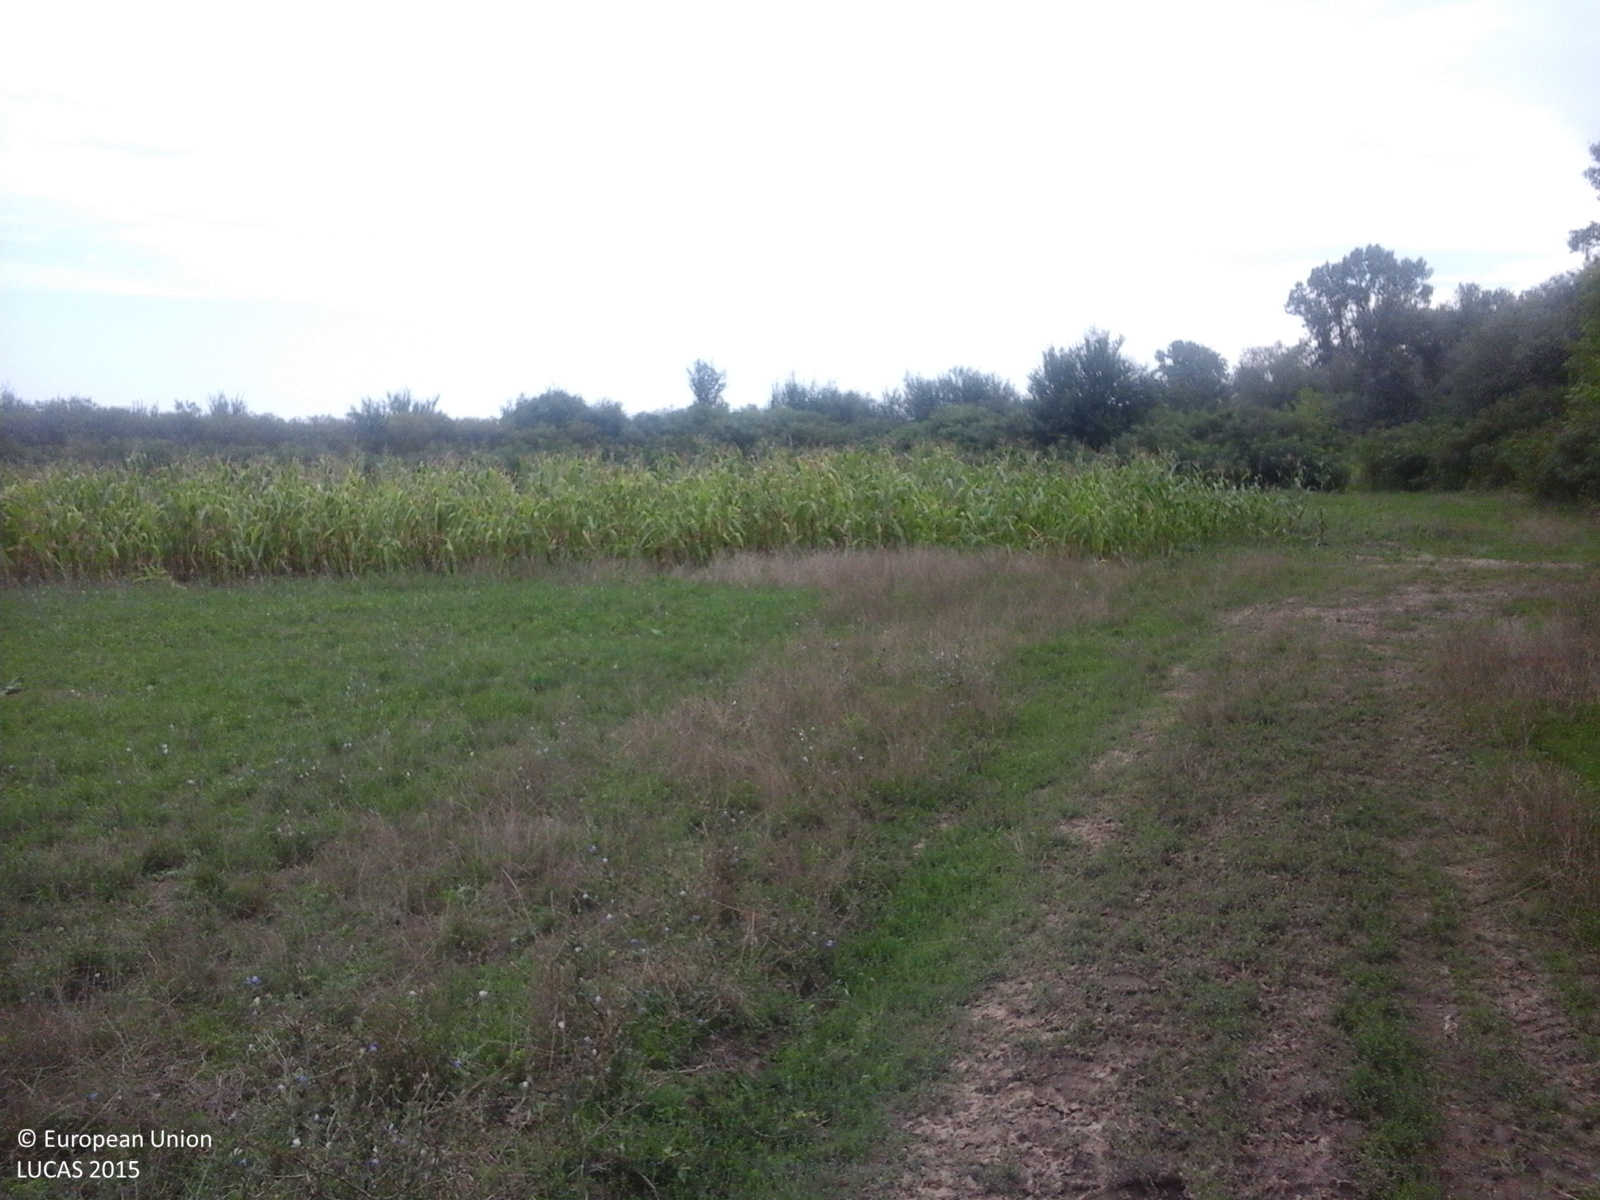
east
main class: Cropland
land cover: Lucerne
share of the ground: > 75 %
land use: Agriculture (excluding fallow land and kitchen gardens)
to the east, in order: Tracks; Lucerne; Maize; Other bare soil; Broadleaved woodland; Maize; Abandoned hedges; Maize; Spontaneously vegetated surfaces; Maize; Shruby margins; Maize
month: August
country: RO
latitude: 46.0925
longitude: 21.6654
